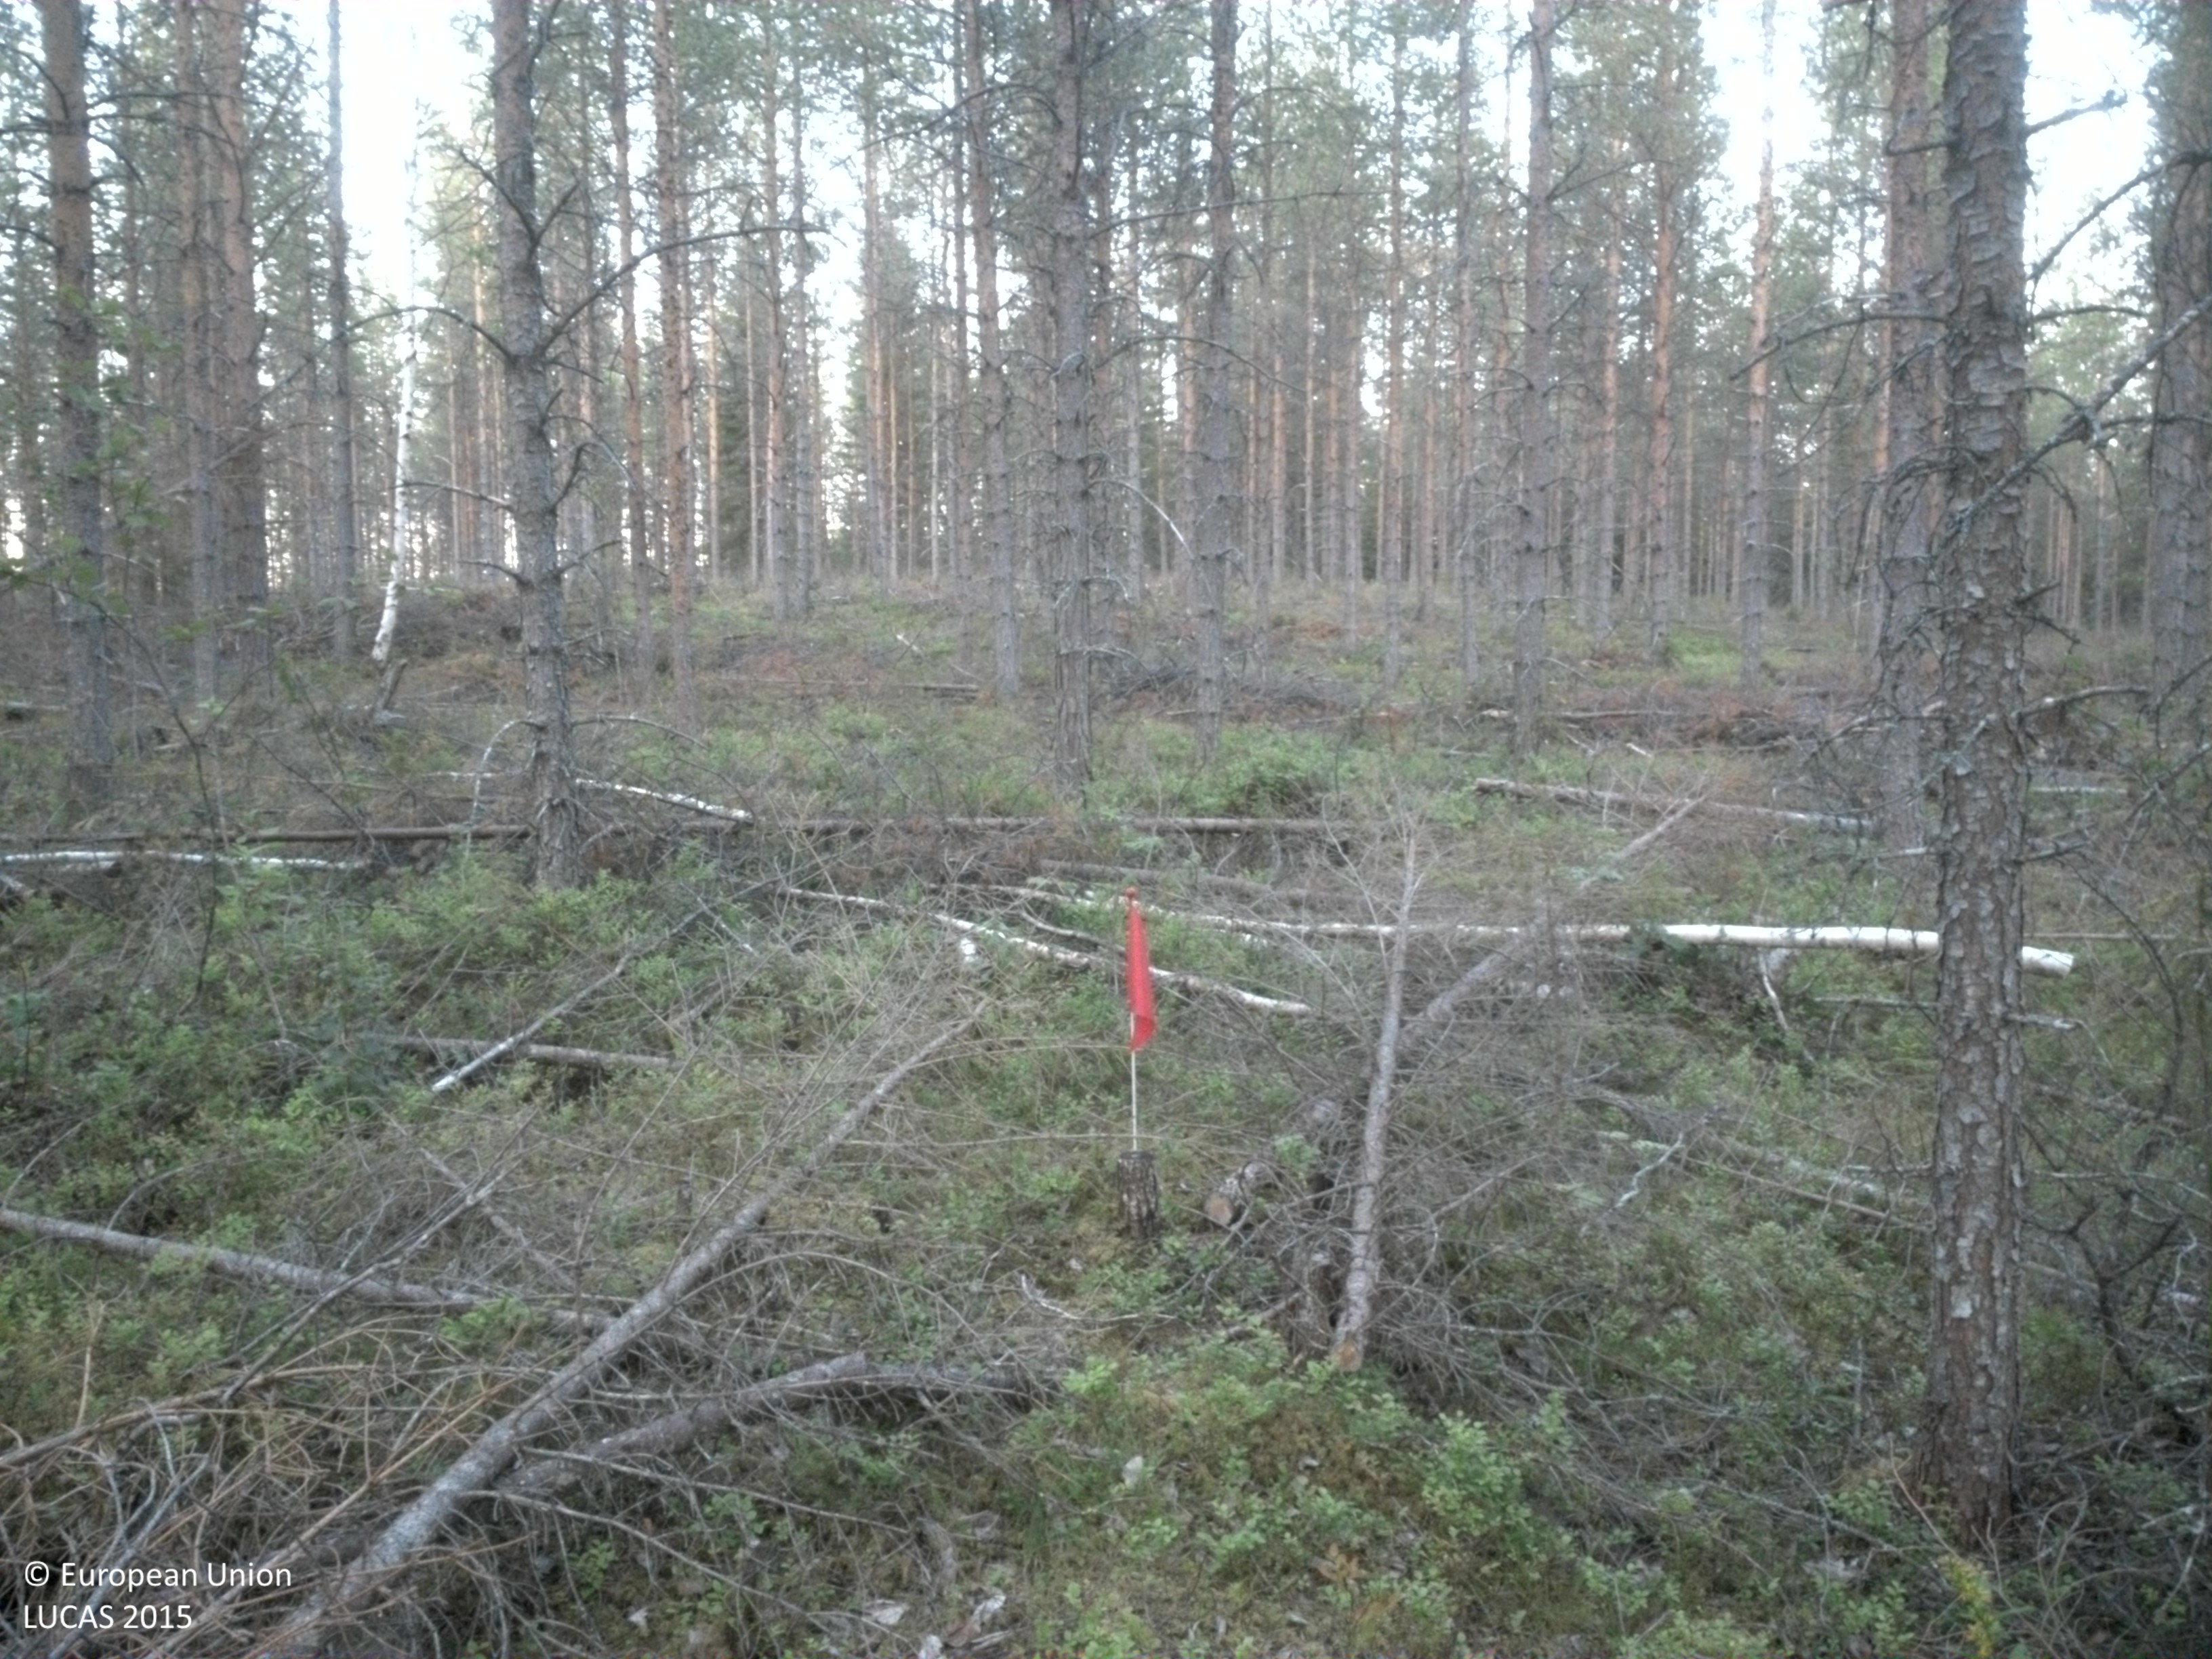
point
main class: Woodland
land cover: Pine dominated coniferous woodland
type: boreal forest
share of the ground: 50 - 75 %
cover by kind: coniferous forest trees 60 %, shrubs 30 %, herbaceous plants 5 %, lichens and mosses 5 %
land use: Forestry
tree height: > 5 m
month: August
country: SE
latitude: 64.6078
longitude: 18.4741
